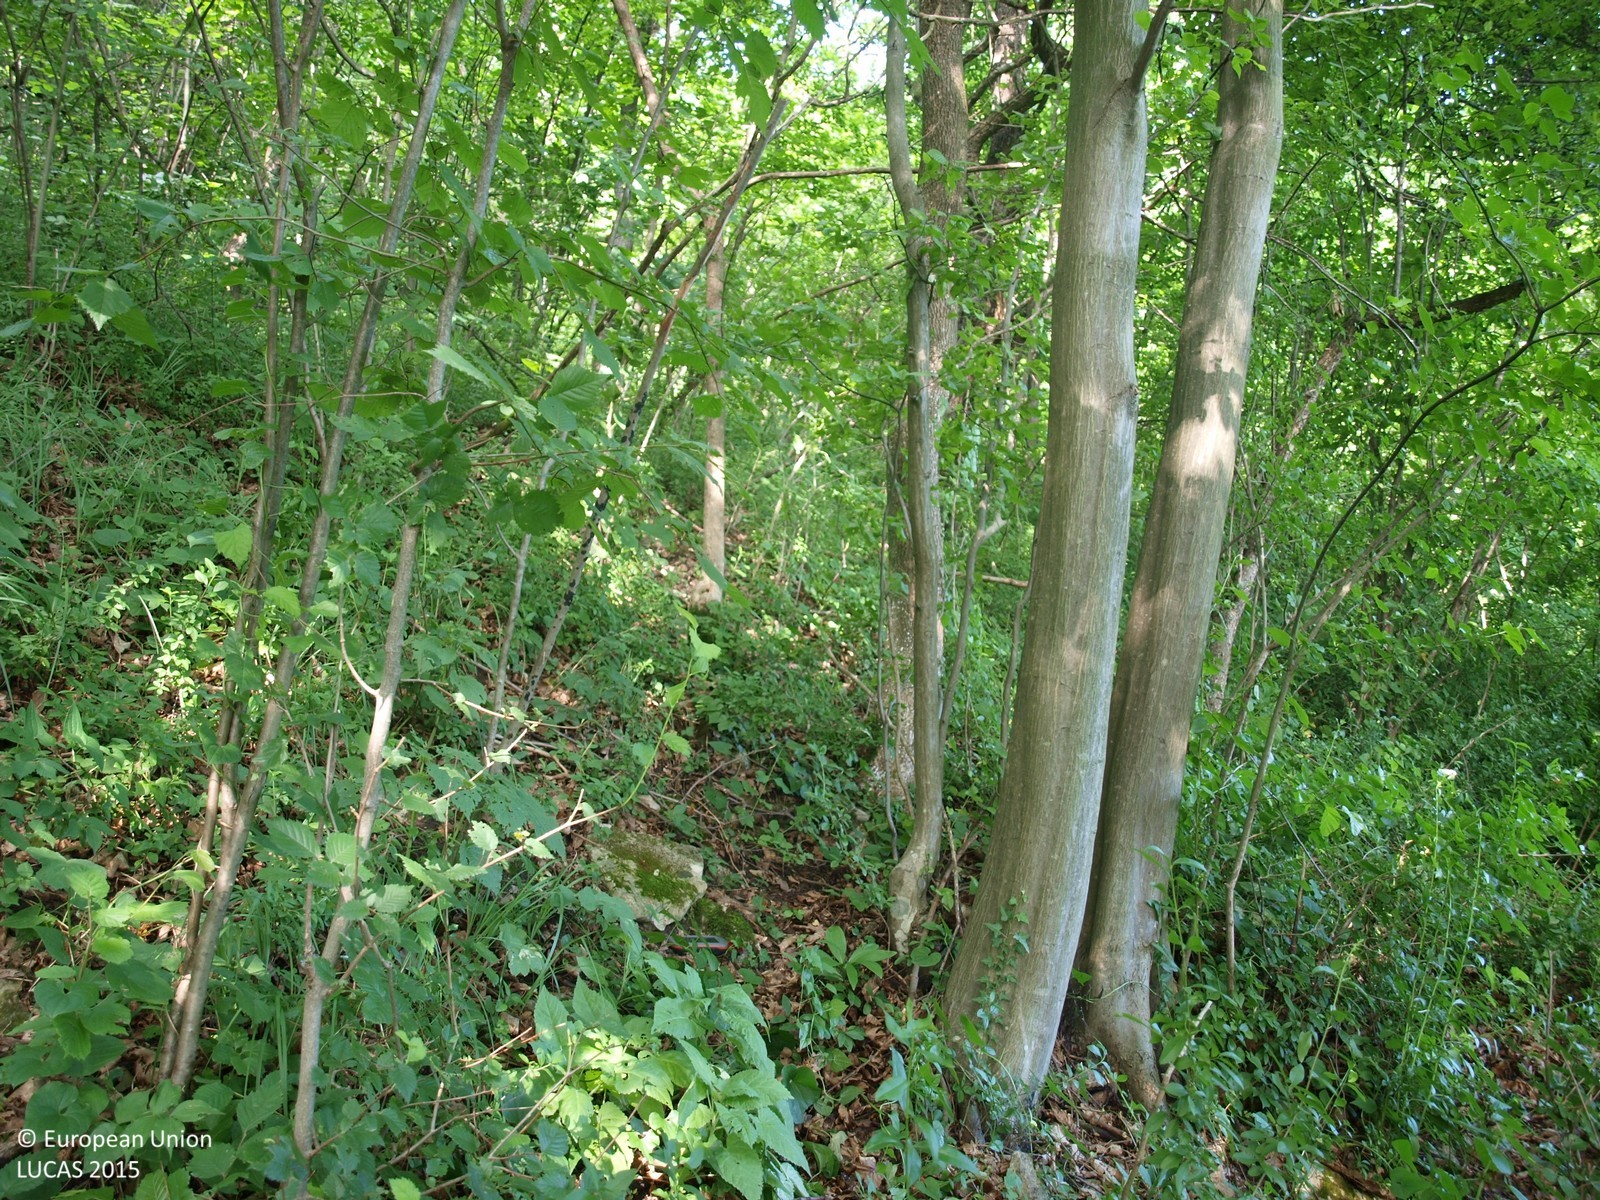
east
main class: Woodland
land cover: Broadleaved woodland
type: mesophytic deciduous forest
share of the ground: > 75 %
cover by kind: broadleaved forest trees 100 %
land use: Forestry
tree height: > 5 m
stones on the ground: < 10 %
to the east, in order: Broadleaved woodland; Spruce dominated coniferous woodland; Broadleaved woodland
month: June
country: HR
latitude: 46.1768
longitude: 16.4121
